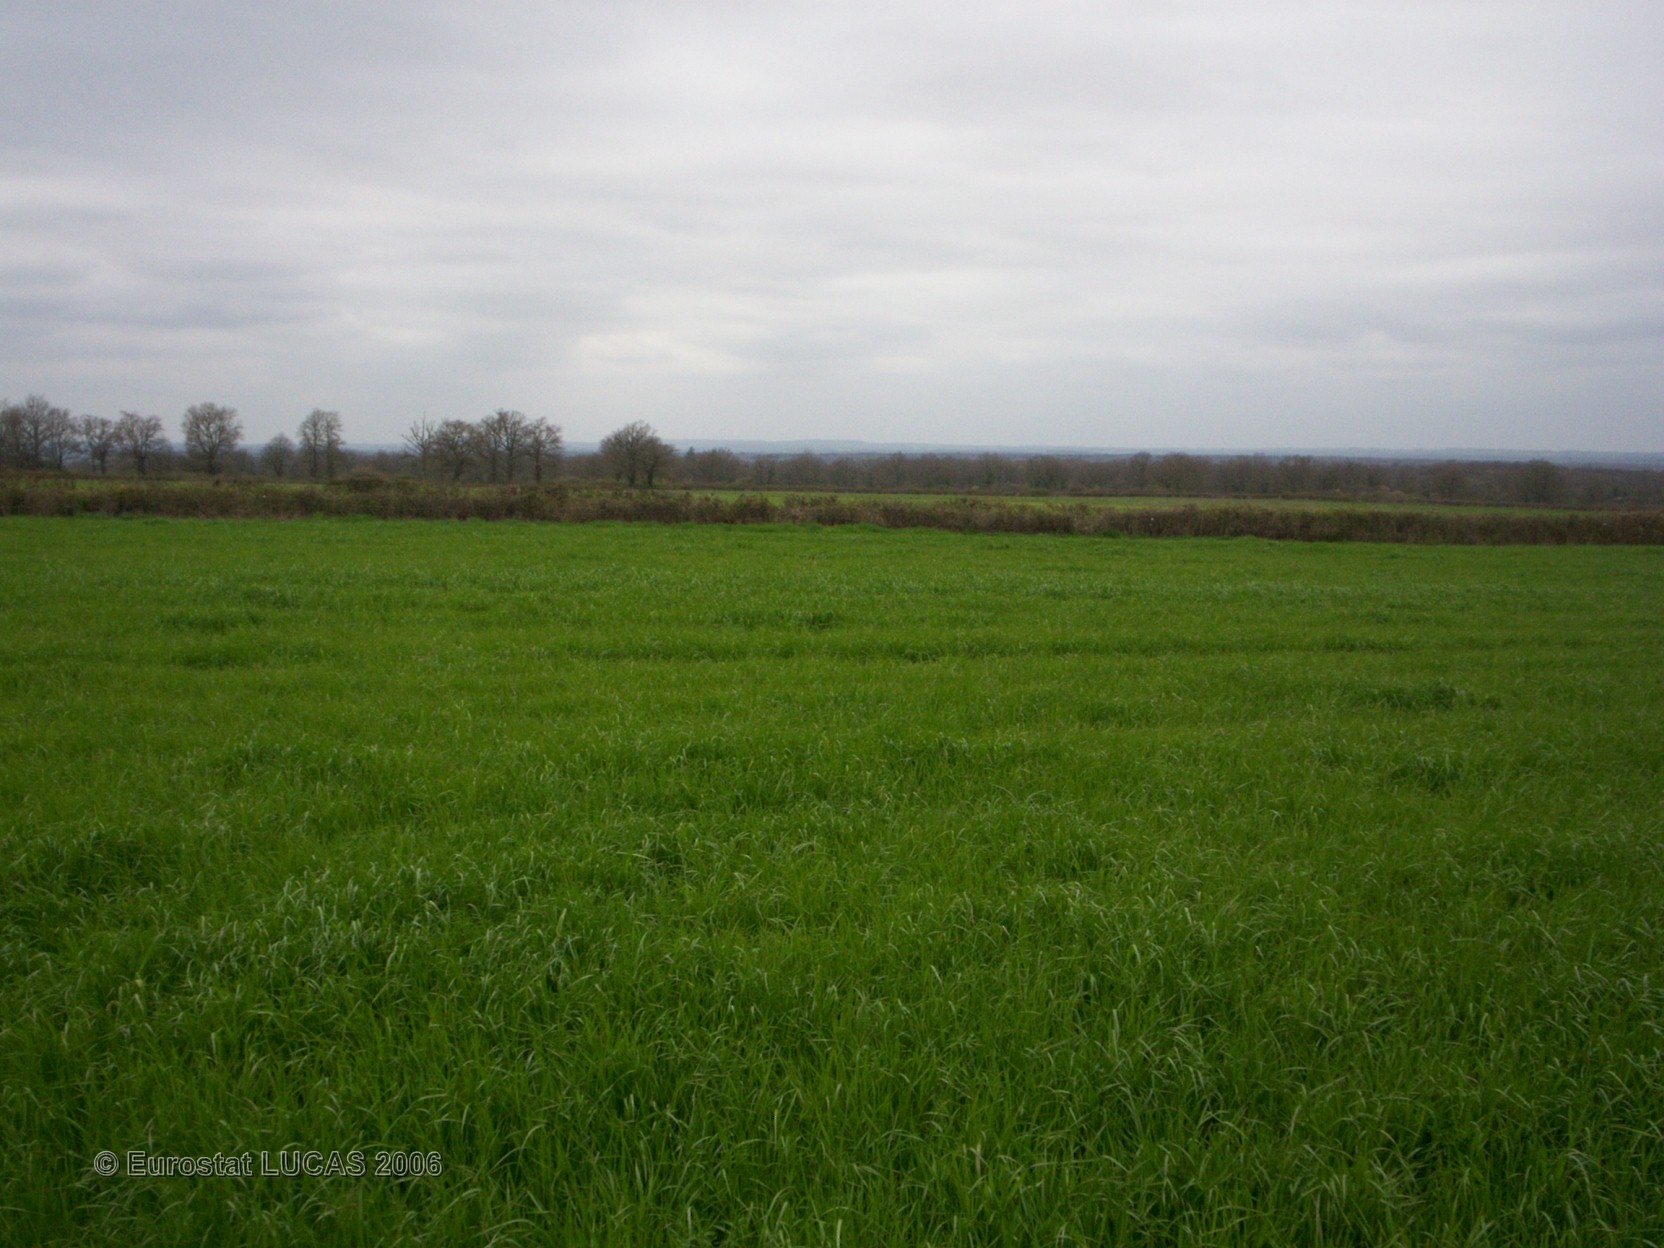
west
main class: Cropland
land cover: Barley
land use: Agriculture (excluding fallow land and kitchen gardens)
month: April
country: FR
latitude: 46.6677
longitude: 3.0564
